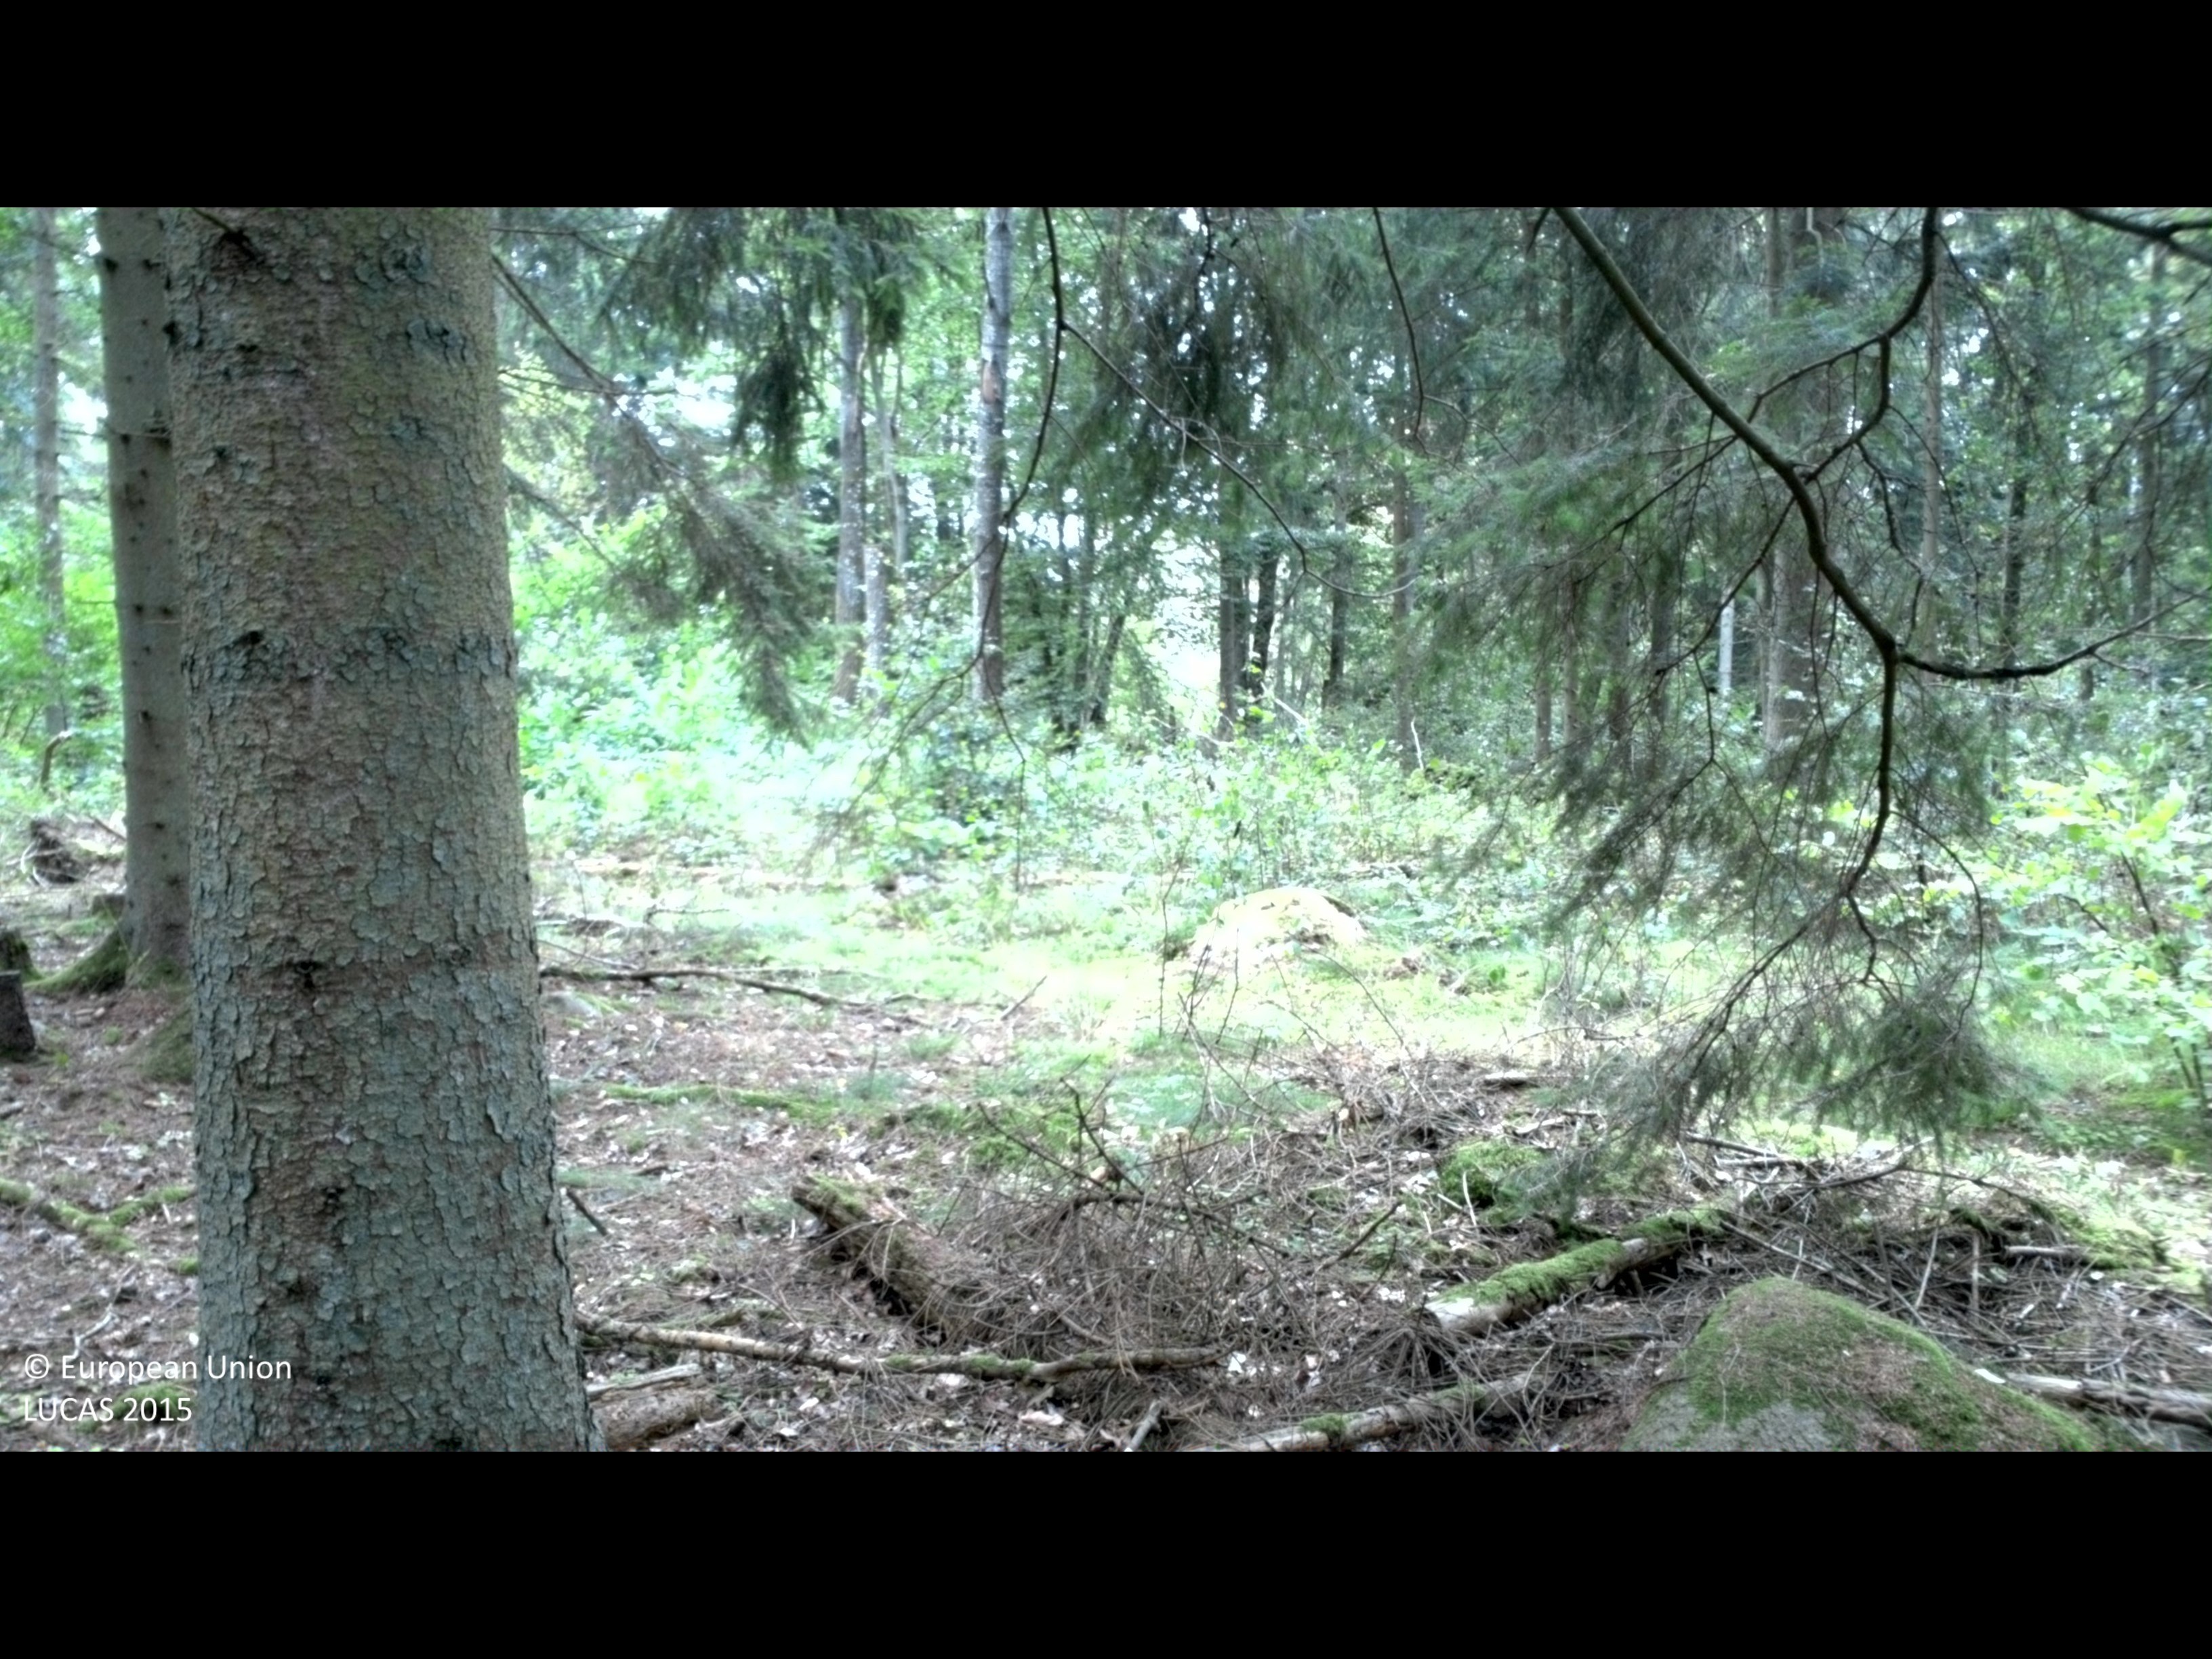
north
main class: Woodland
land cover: Spruce dominated coniferous woodland
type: boreal forest
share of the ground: > 75 %
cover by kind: coniferous forest trees 75 %, lichens and mosses 15 %, broadleaved forest trees 5 %, shrubs 5 %
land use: Forestry
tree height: > 5 m
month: September
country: SE
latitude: 56.1223
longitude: 14.0996
